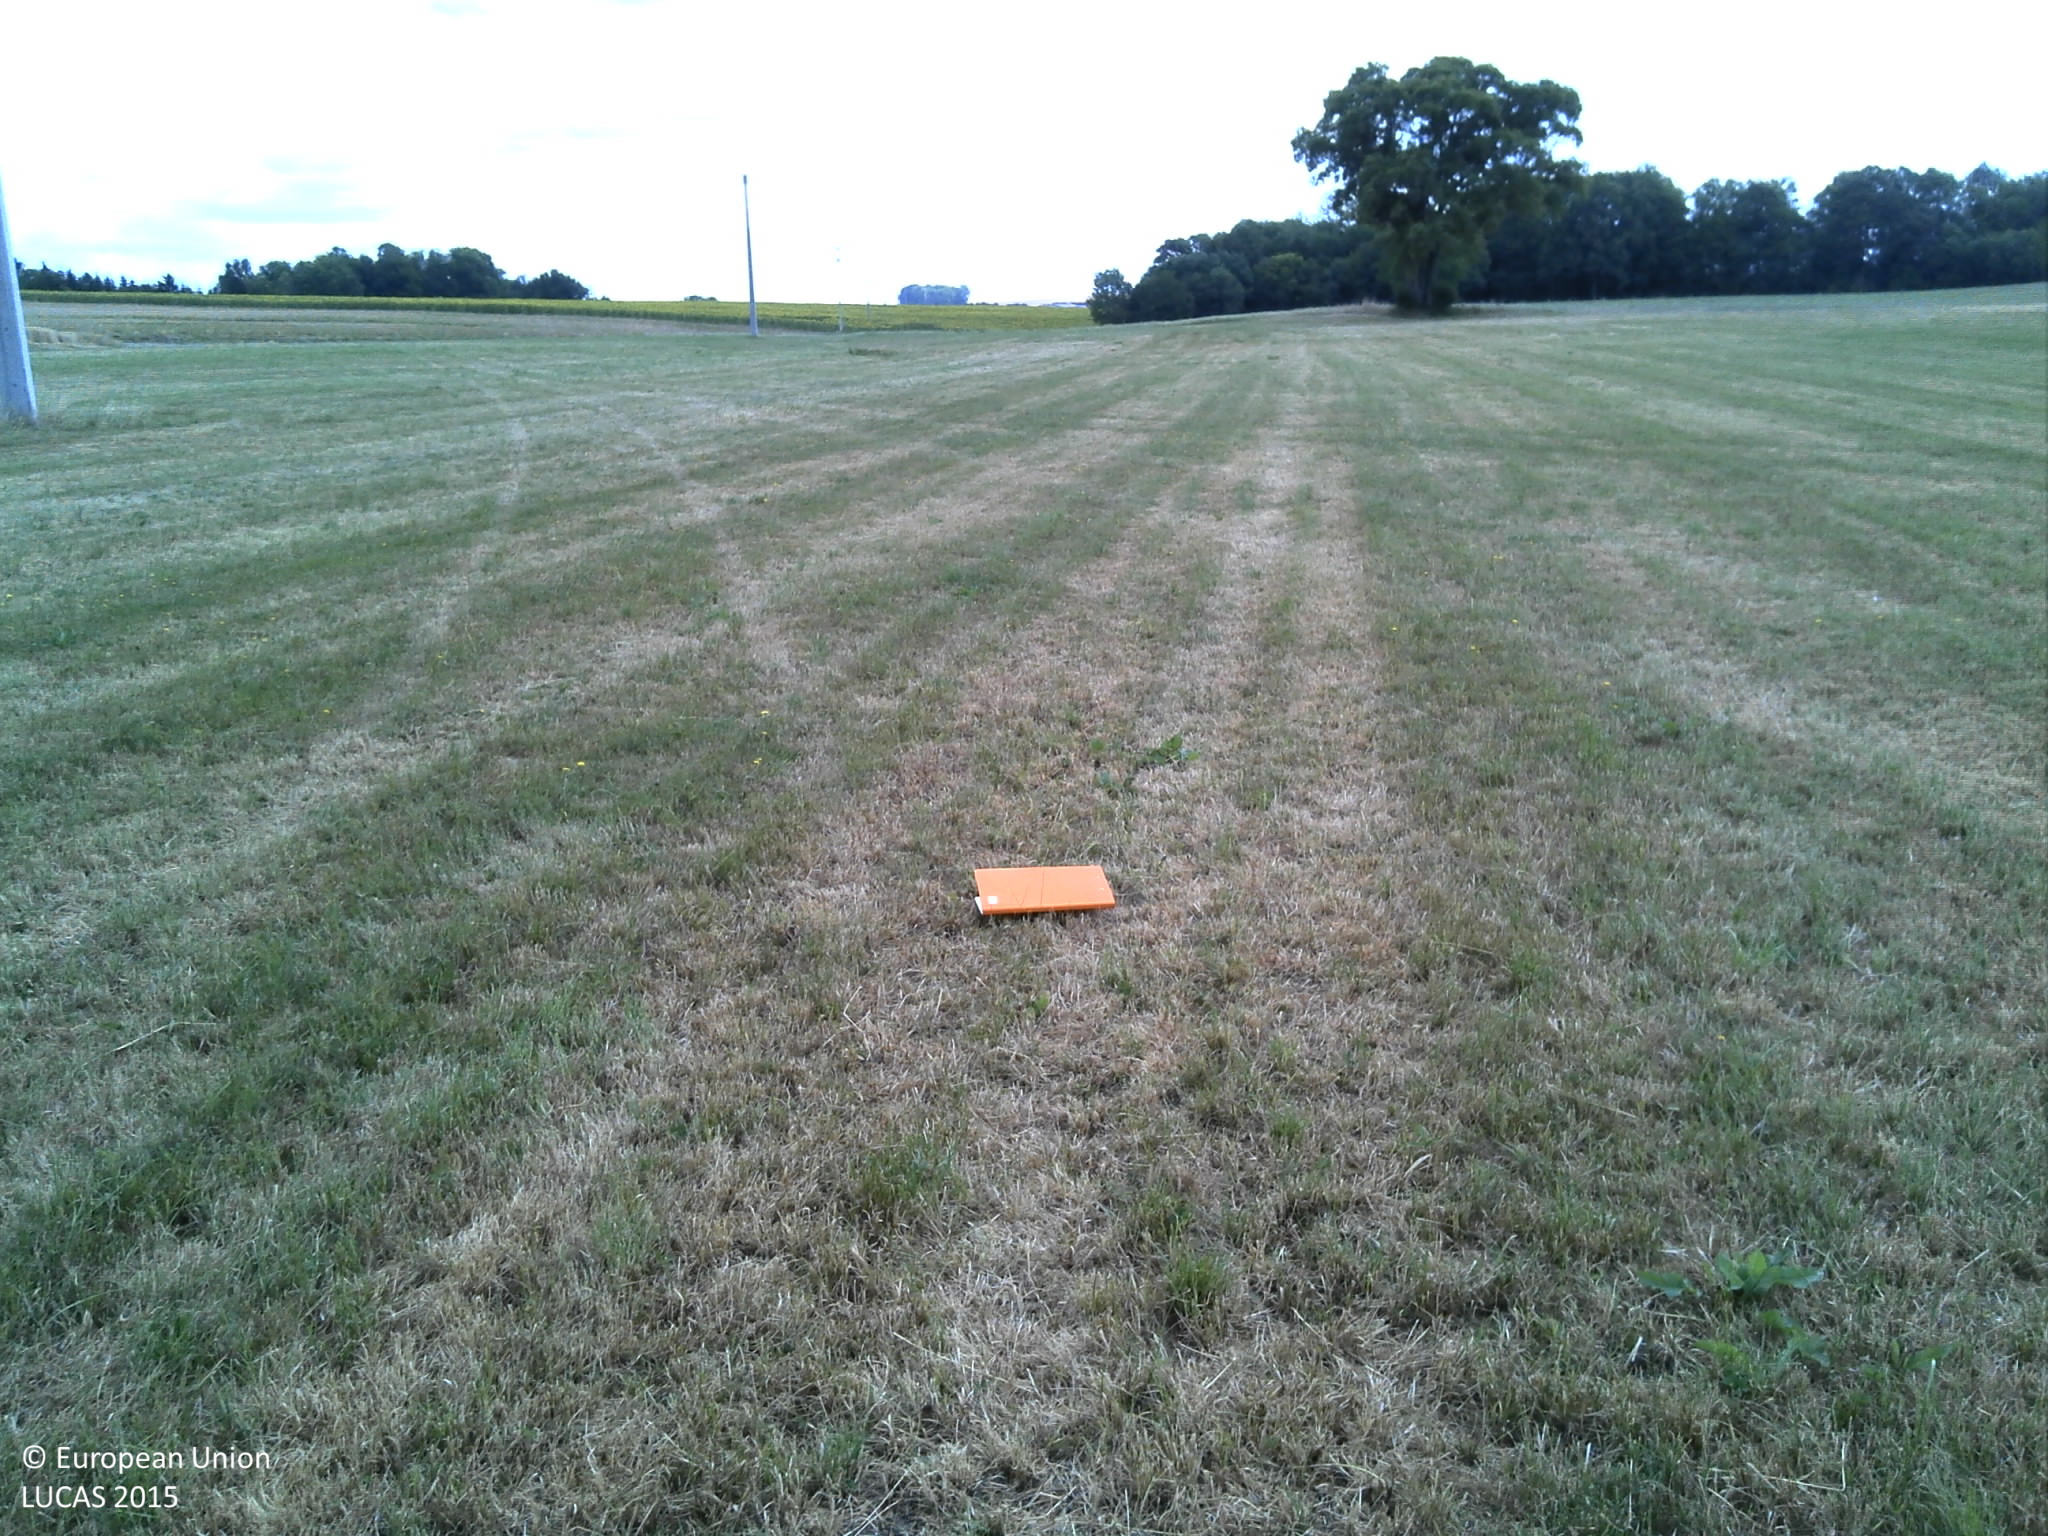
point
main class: Grassland
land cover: Grassland without tree/shrub cover
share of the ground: > 75 %
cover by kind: herbaceous plants 100 %
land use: Agriculture (excluding fallow land and kitchen gardens)
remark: Harvested field
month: July
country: FR
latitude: 48.1759
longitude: 6.1947
